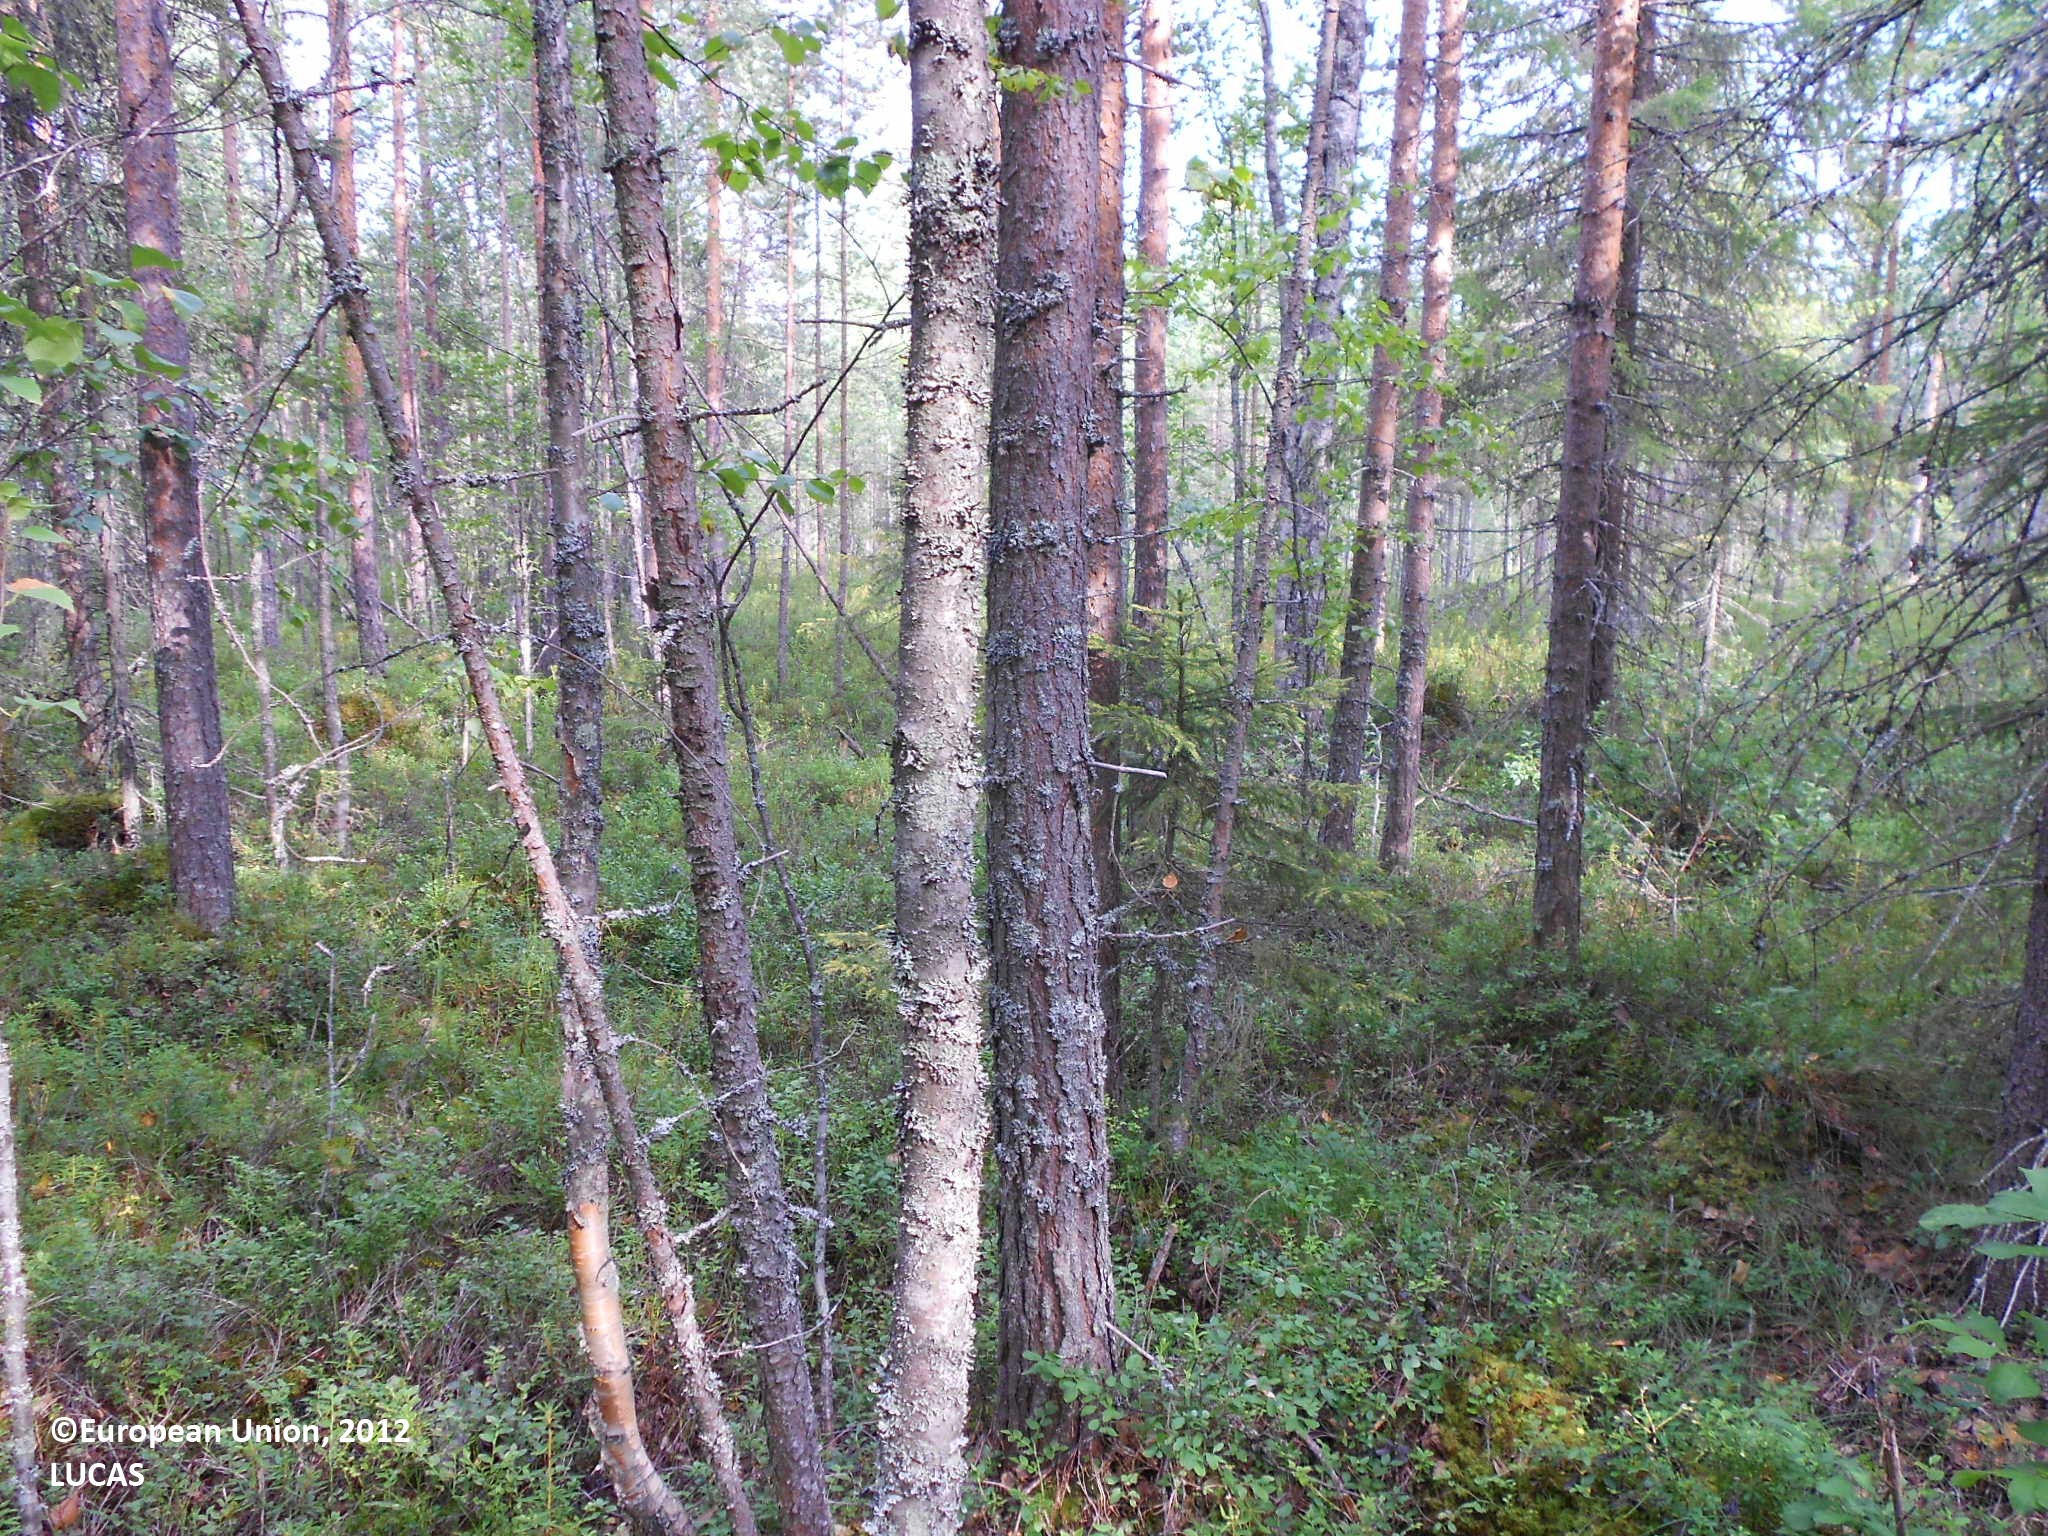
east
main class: Woodland
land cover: Pine dominated coniferous woodland
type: boreal forest
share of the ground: 50 - 75 %
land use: Forestry
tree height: > 5 m
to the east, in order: Pine dominated coniferous woodland; Broadleaved woodland; Electric lines; Broadleaved woodland; Pine dominated coniferous woodland
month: August
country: FI
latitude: 63.3724
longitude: 29.0708
